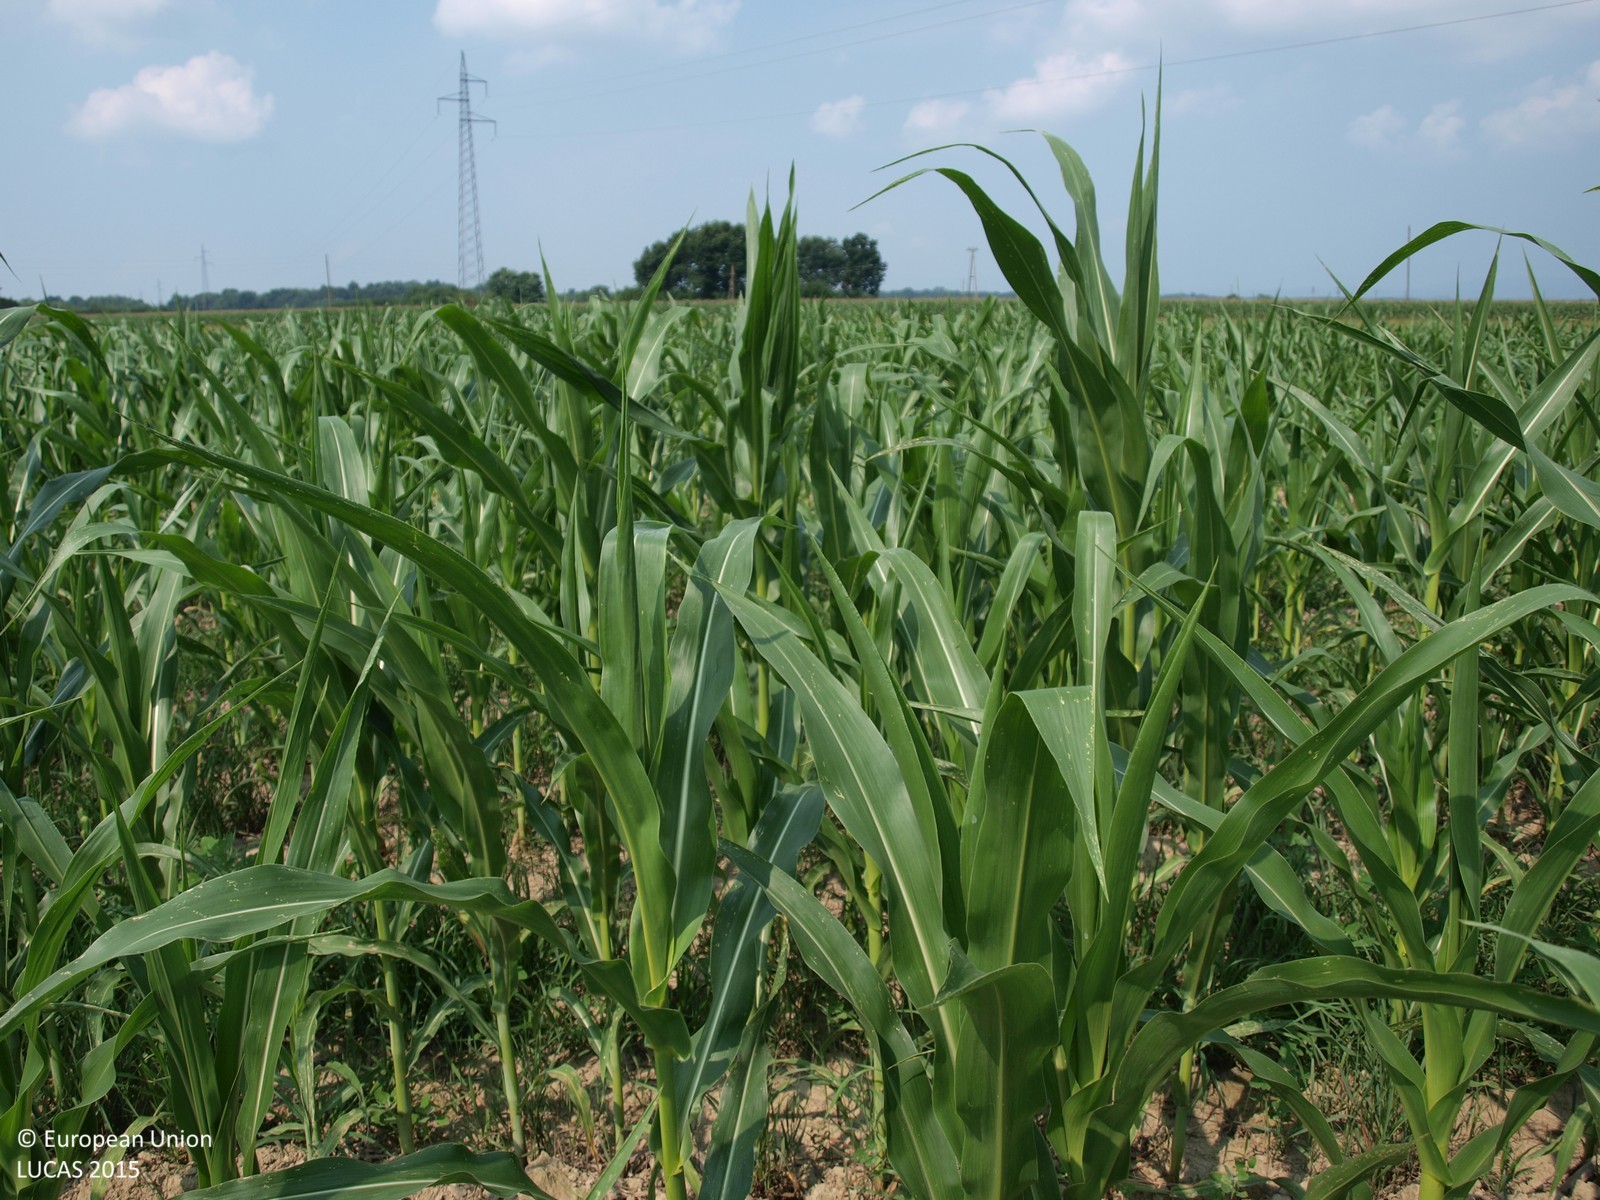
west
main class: Cropland
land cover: Maize
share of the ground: > 75 %
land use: Agriculture (excluding fallow land and kitchen gardens)
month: August
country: HR
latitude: 45.8898
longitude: 16.3781
